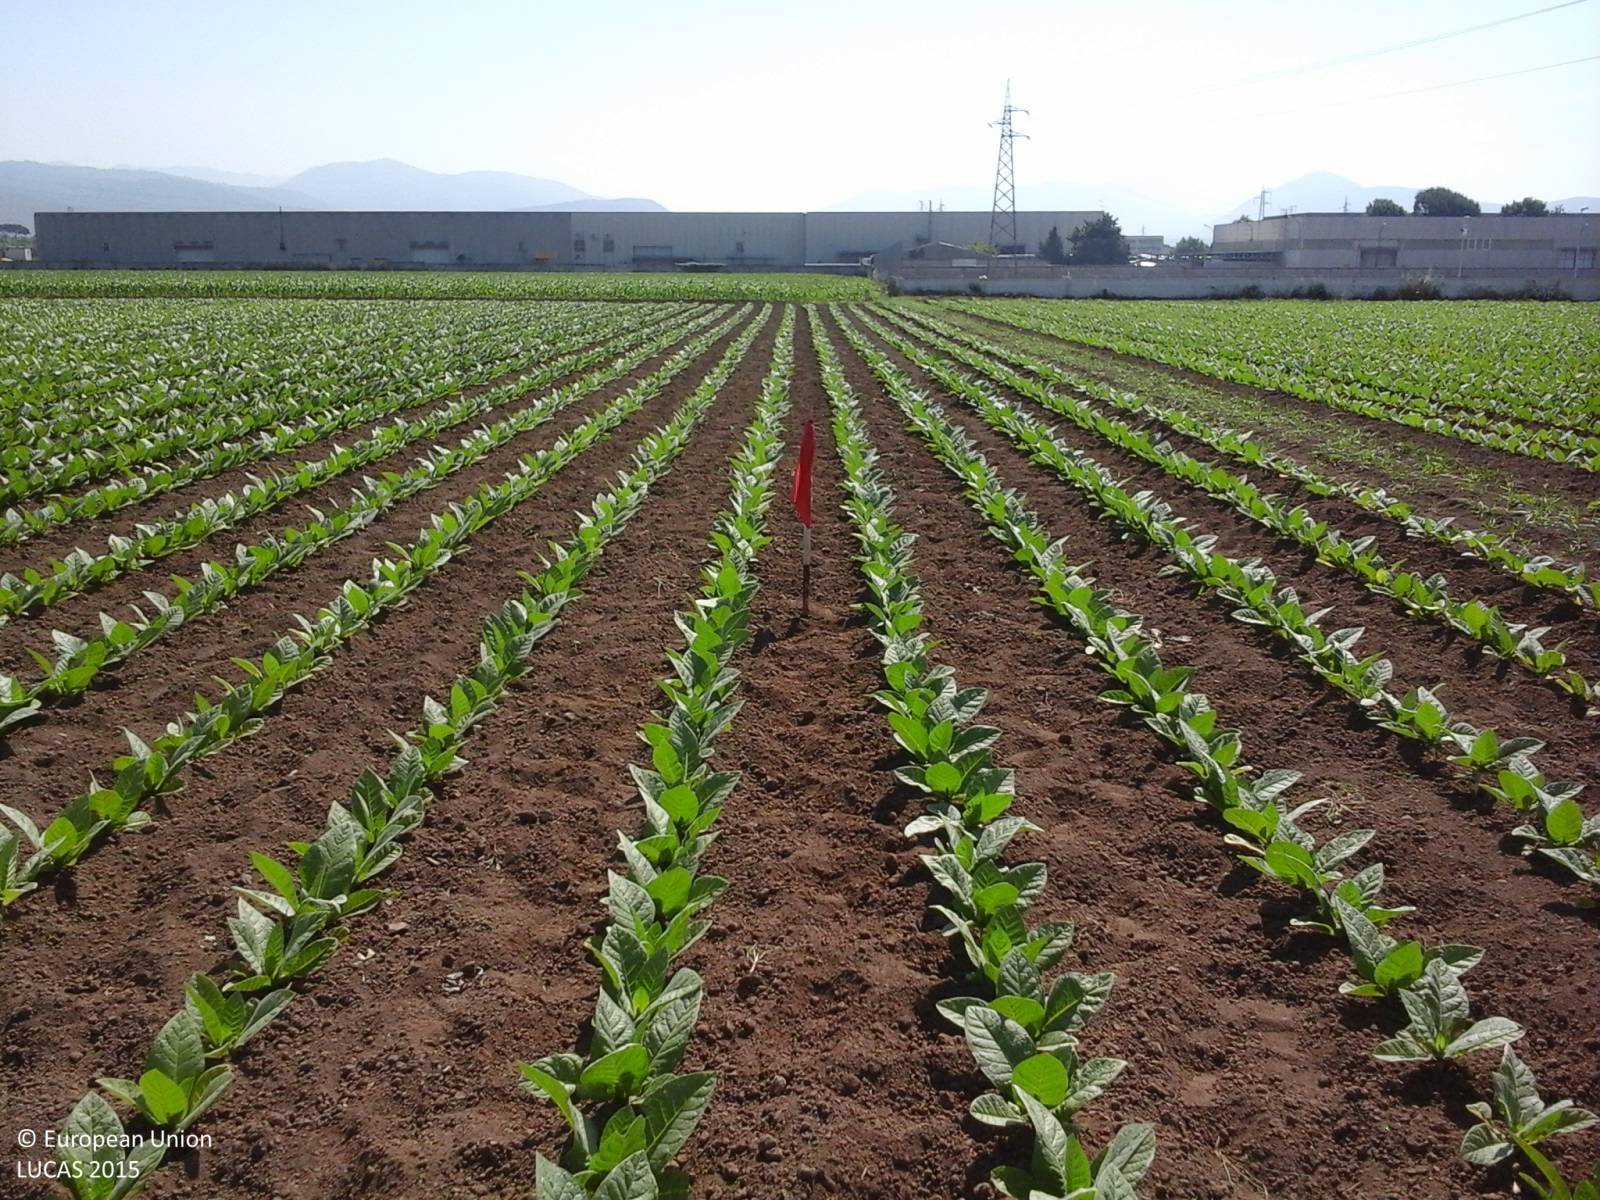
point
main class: Cropland
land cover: Tobacco
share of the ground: 25 - 50 %
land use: Agriculture (excluding fallow land and kitchen gardens)
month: June
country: IT
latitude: 41.0225
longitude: 14.3471
